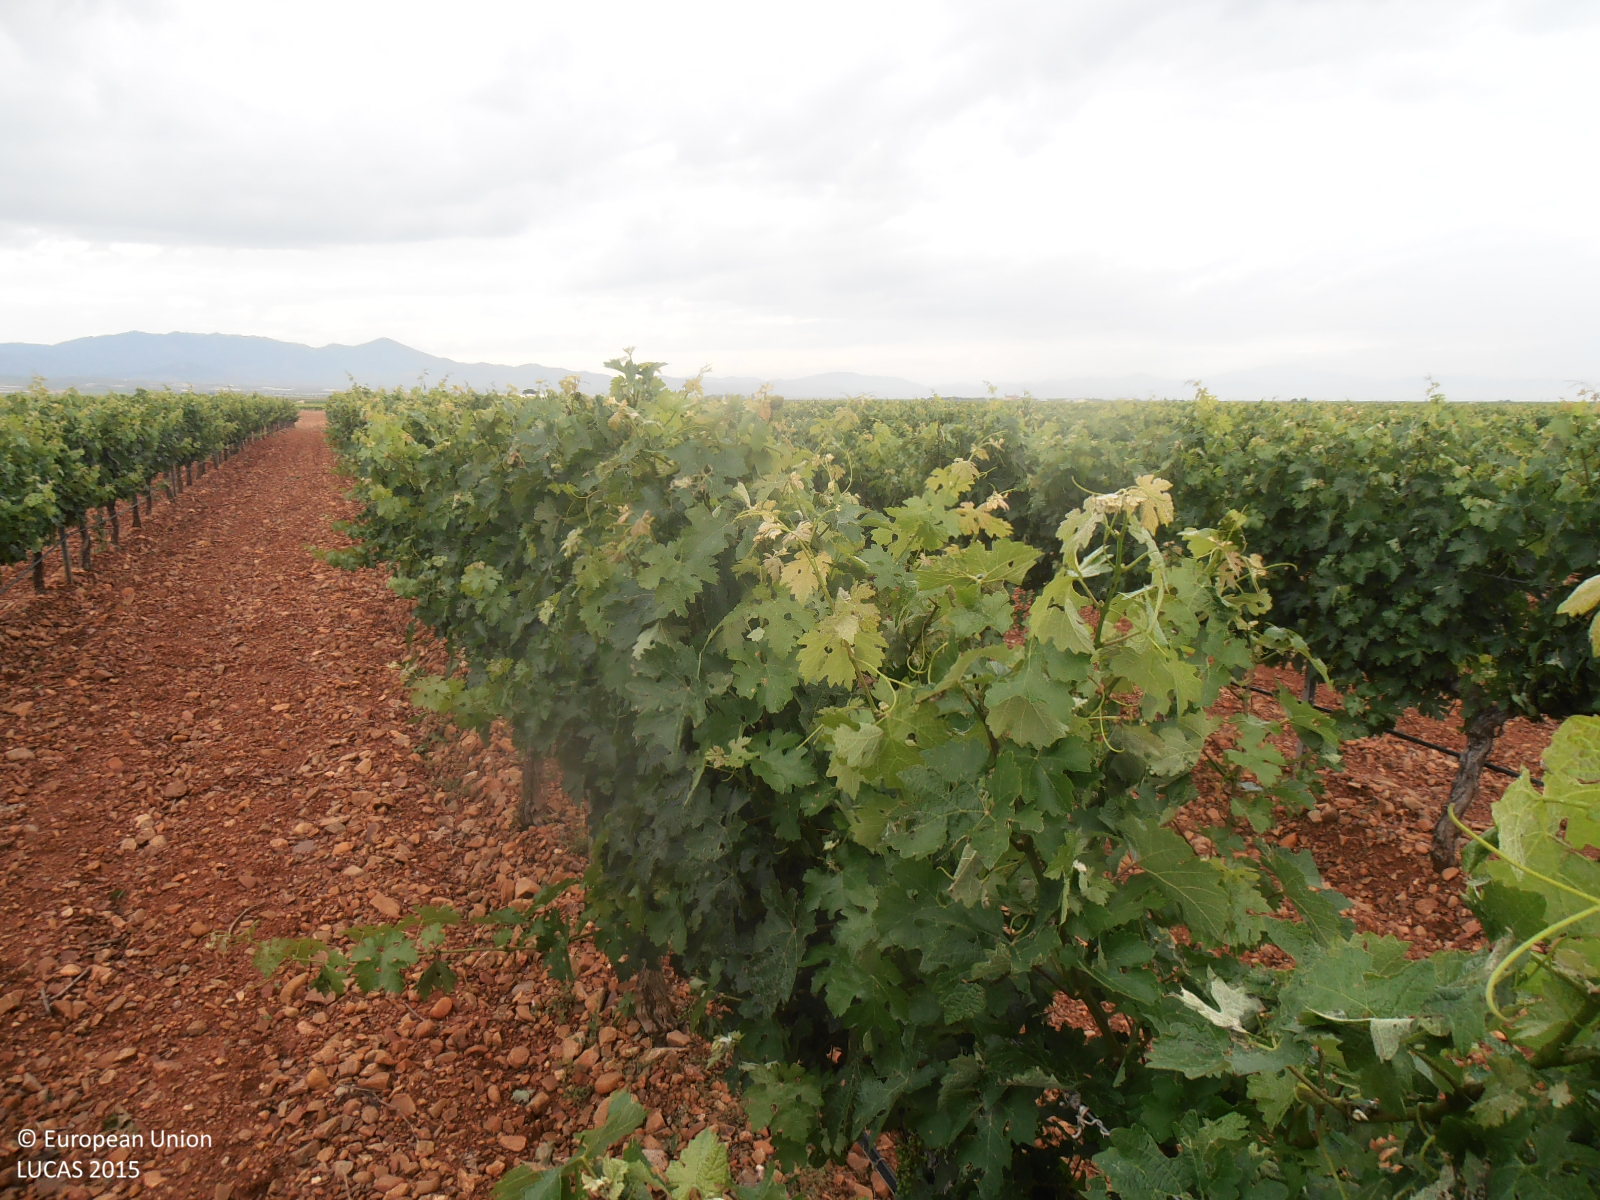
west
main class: Cropland
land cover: Vineyards
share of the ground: 25 - 50 %
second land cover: Other bare soil
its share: > 75 %
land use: Agriculture (excluding fallow land and kitchen gardens)
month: June
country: ES
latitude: 41.3926
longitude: -1.2042
